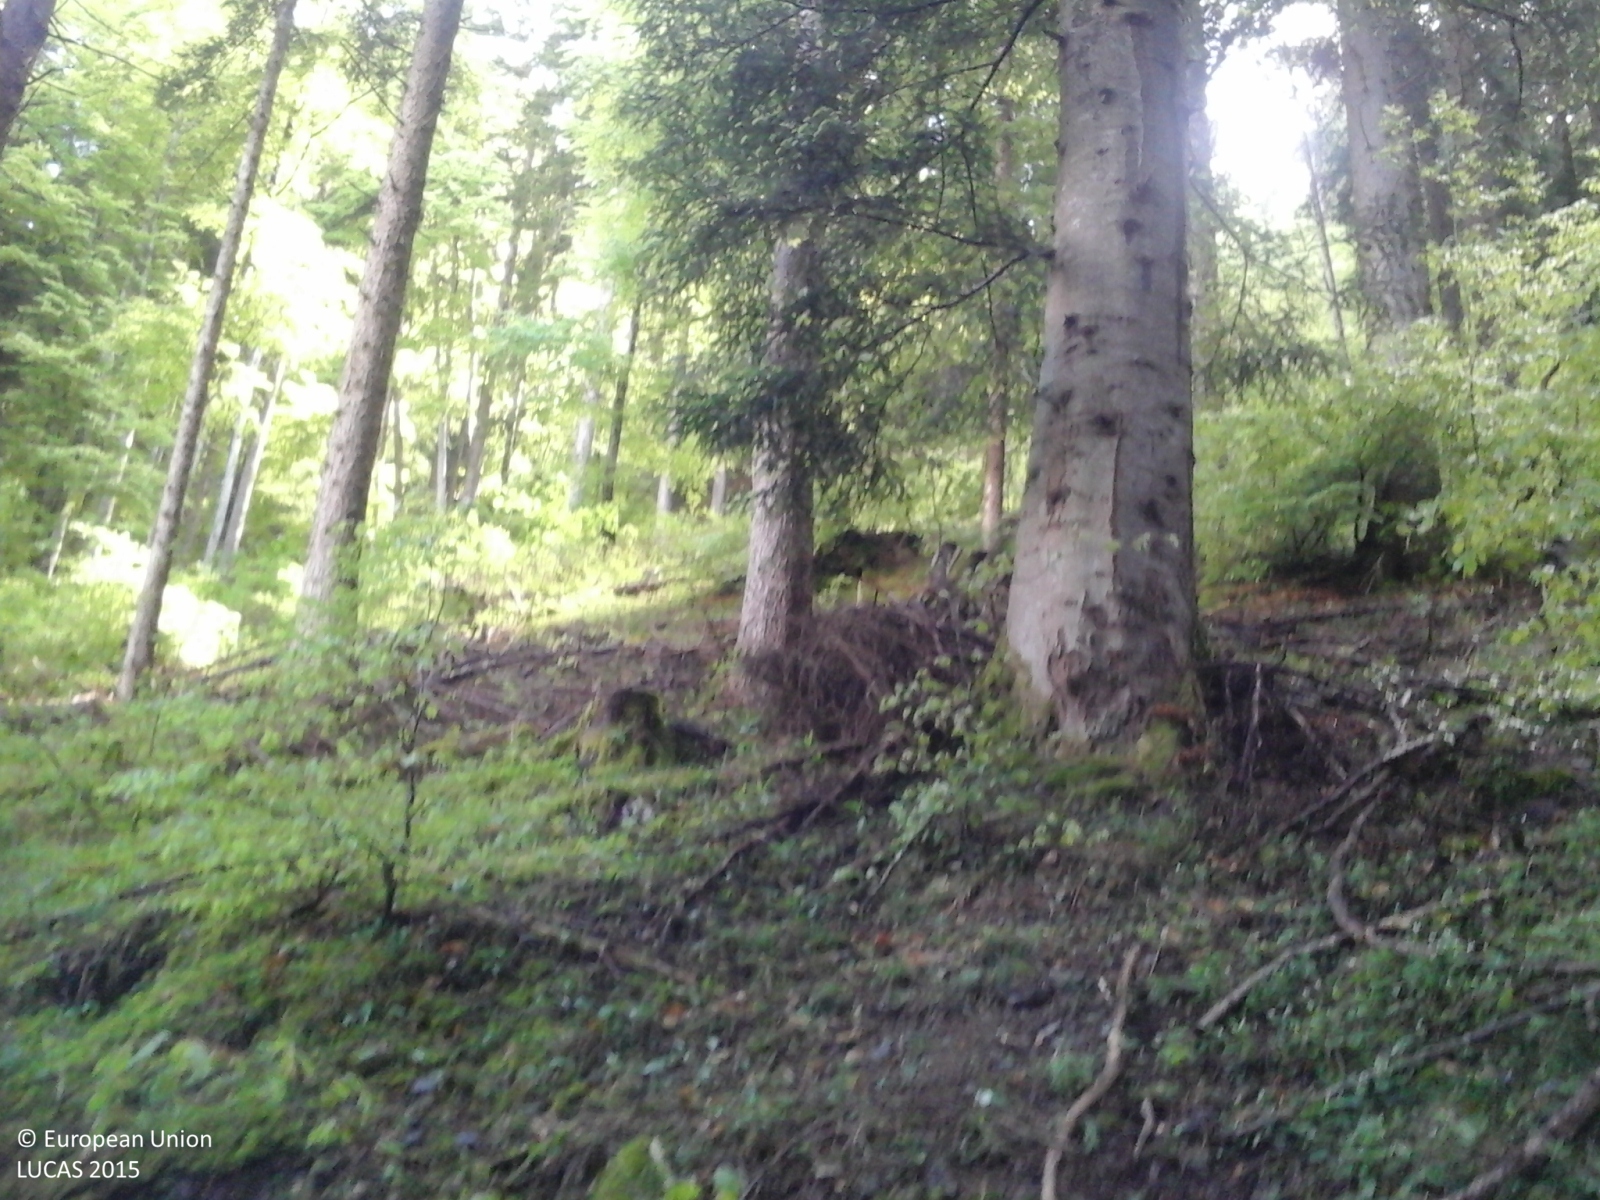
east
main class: Woodland
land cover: Spruce dominated coniferous woodland
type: alpine coniferous forest
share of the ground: > 75 %
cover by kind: coniferous forest trees 90 %, broadleaved forest trees 10 %
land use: Forestry
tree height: > 5 m
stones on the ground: > 50 %
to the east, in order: Spruce dominated coniferous woodland; Tracks; Spruce dominated coniferous woodland
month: May
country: IT
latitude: 46.0784
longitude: 10.7360
